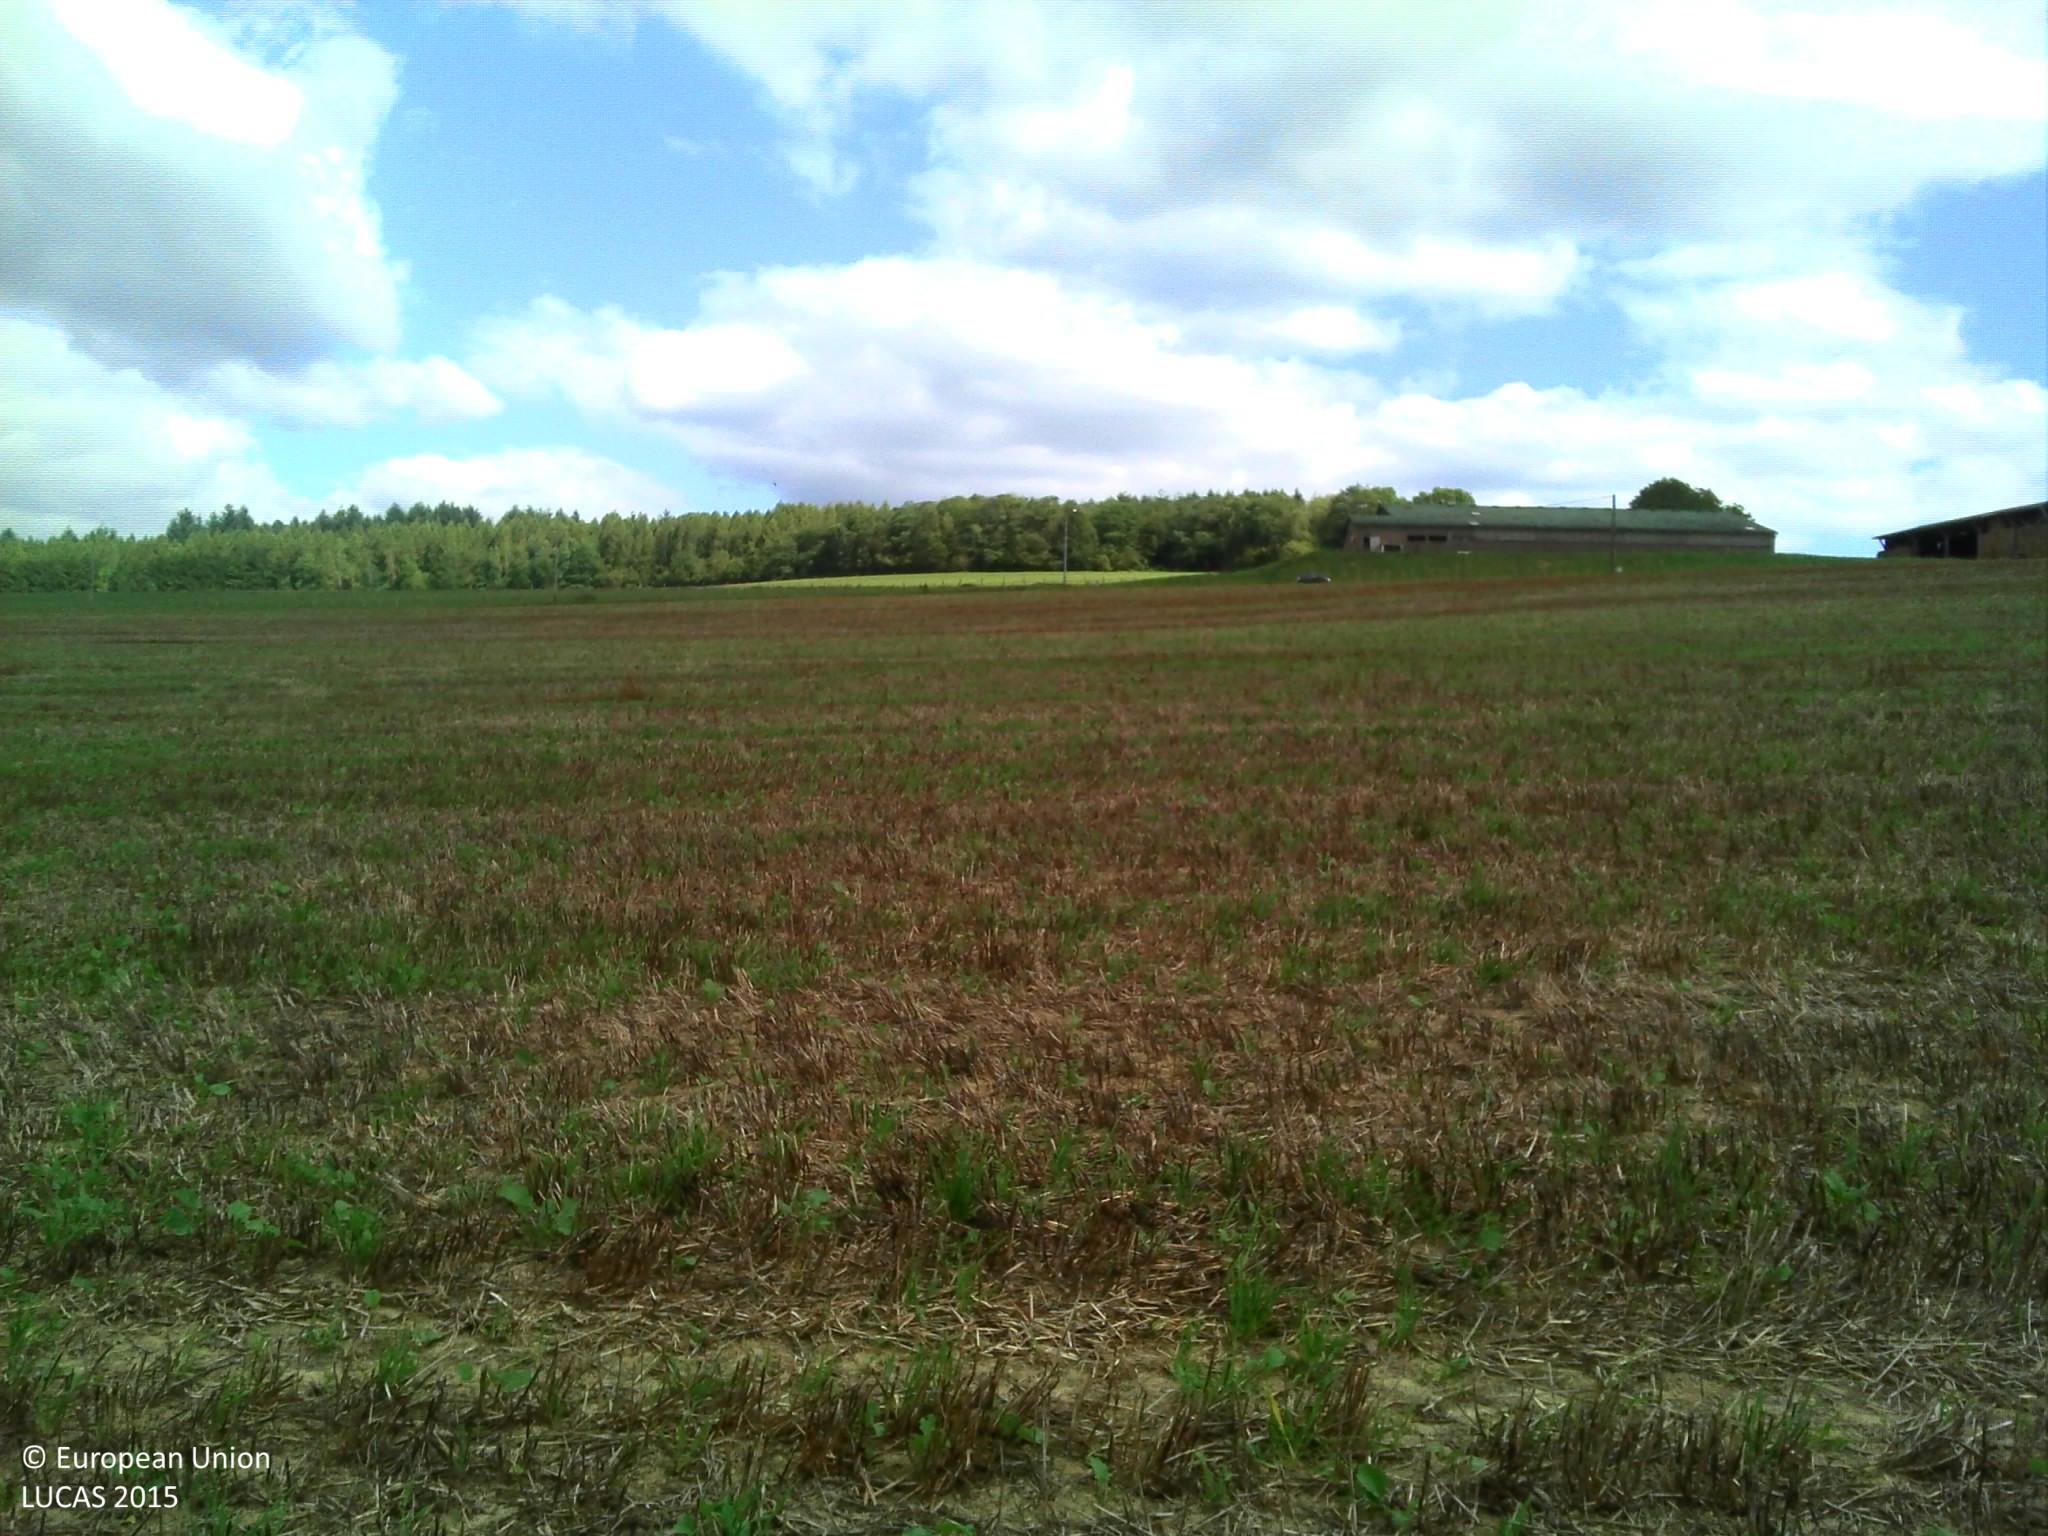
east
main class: Grassland
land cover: Spontaneously vegetated surfaces
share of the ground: > 75 %
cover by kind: herbaceous plants 50 %, unconsolidated bare surface 50 %
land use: Agriculture (excluding fallow land and kitchen gardens)
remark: Harvested field
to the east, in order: Spontaneously vegetated surfaces; Grass margins; Paved roads, cycling and walking lanes; Grass margins; Electric lines; Grass margins; Paved roads, cycling and walking lanes; Fences; Grassland without tree/shrub cover
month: September
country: FR
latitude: 47.3474
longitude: 6.2027
